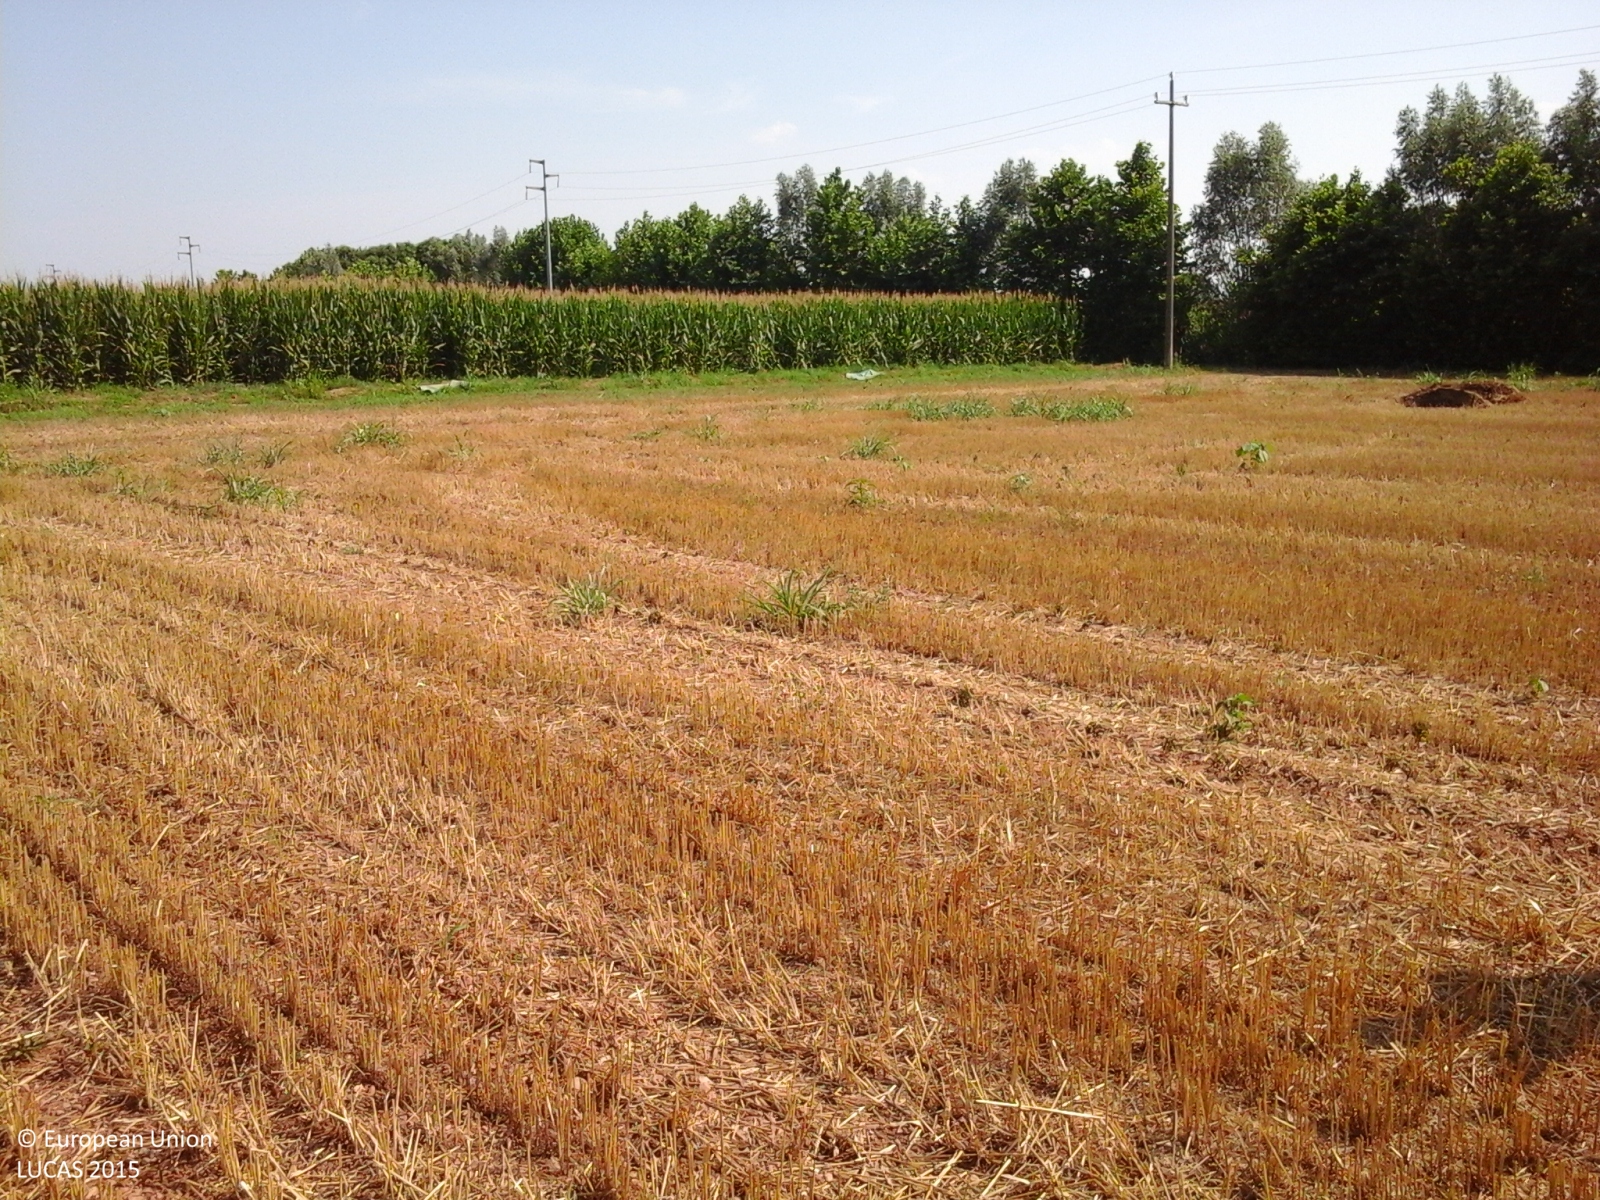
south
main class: Cropland
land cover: Common wheat
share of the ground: 50 - 75 %
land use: Agriculture (excluding fallow land and kitchen gardens)
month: July
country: IT
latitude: 45.6985
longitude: 12.1672
